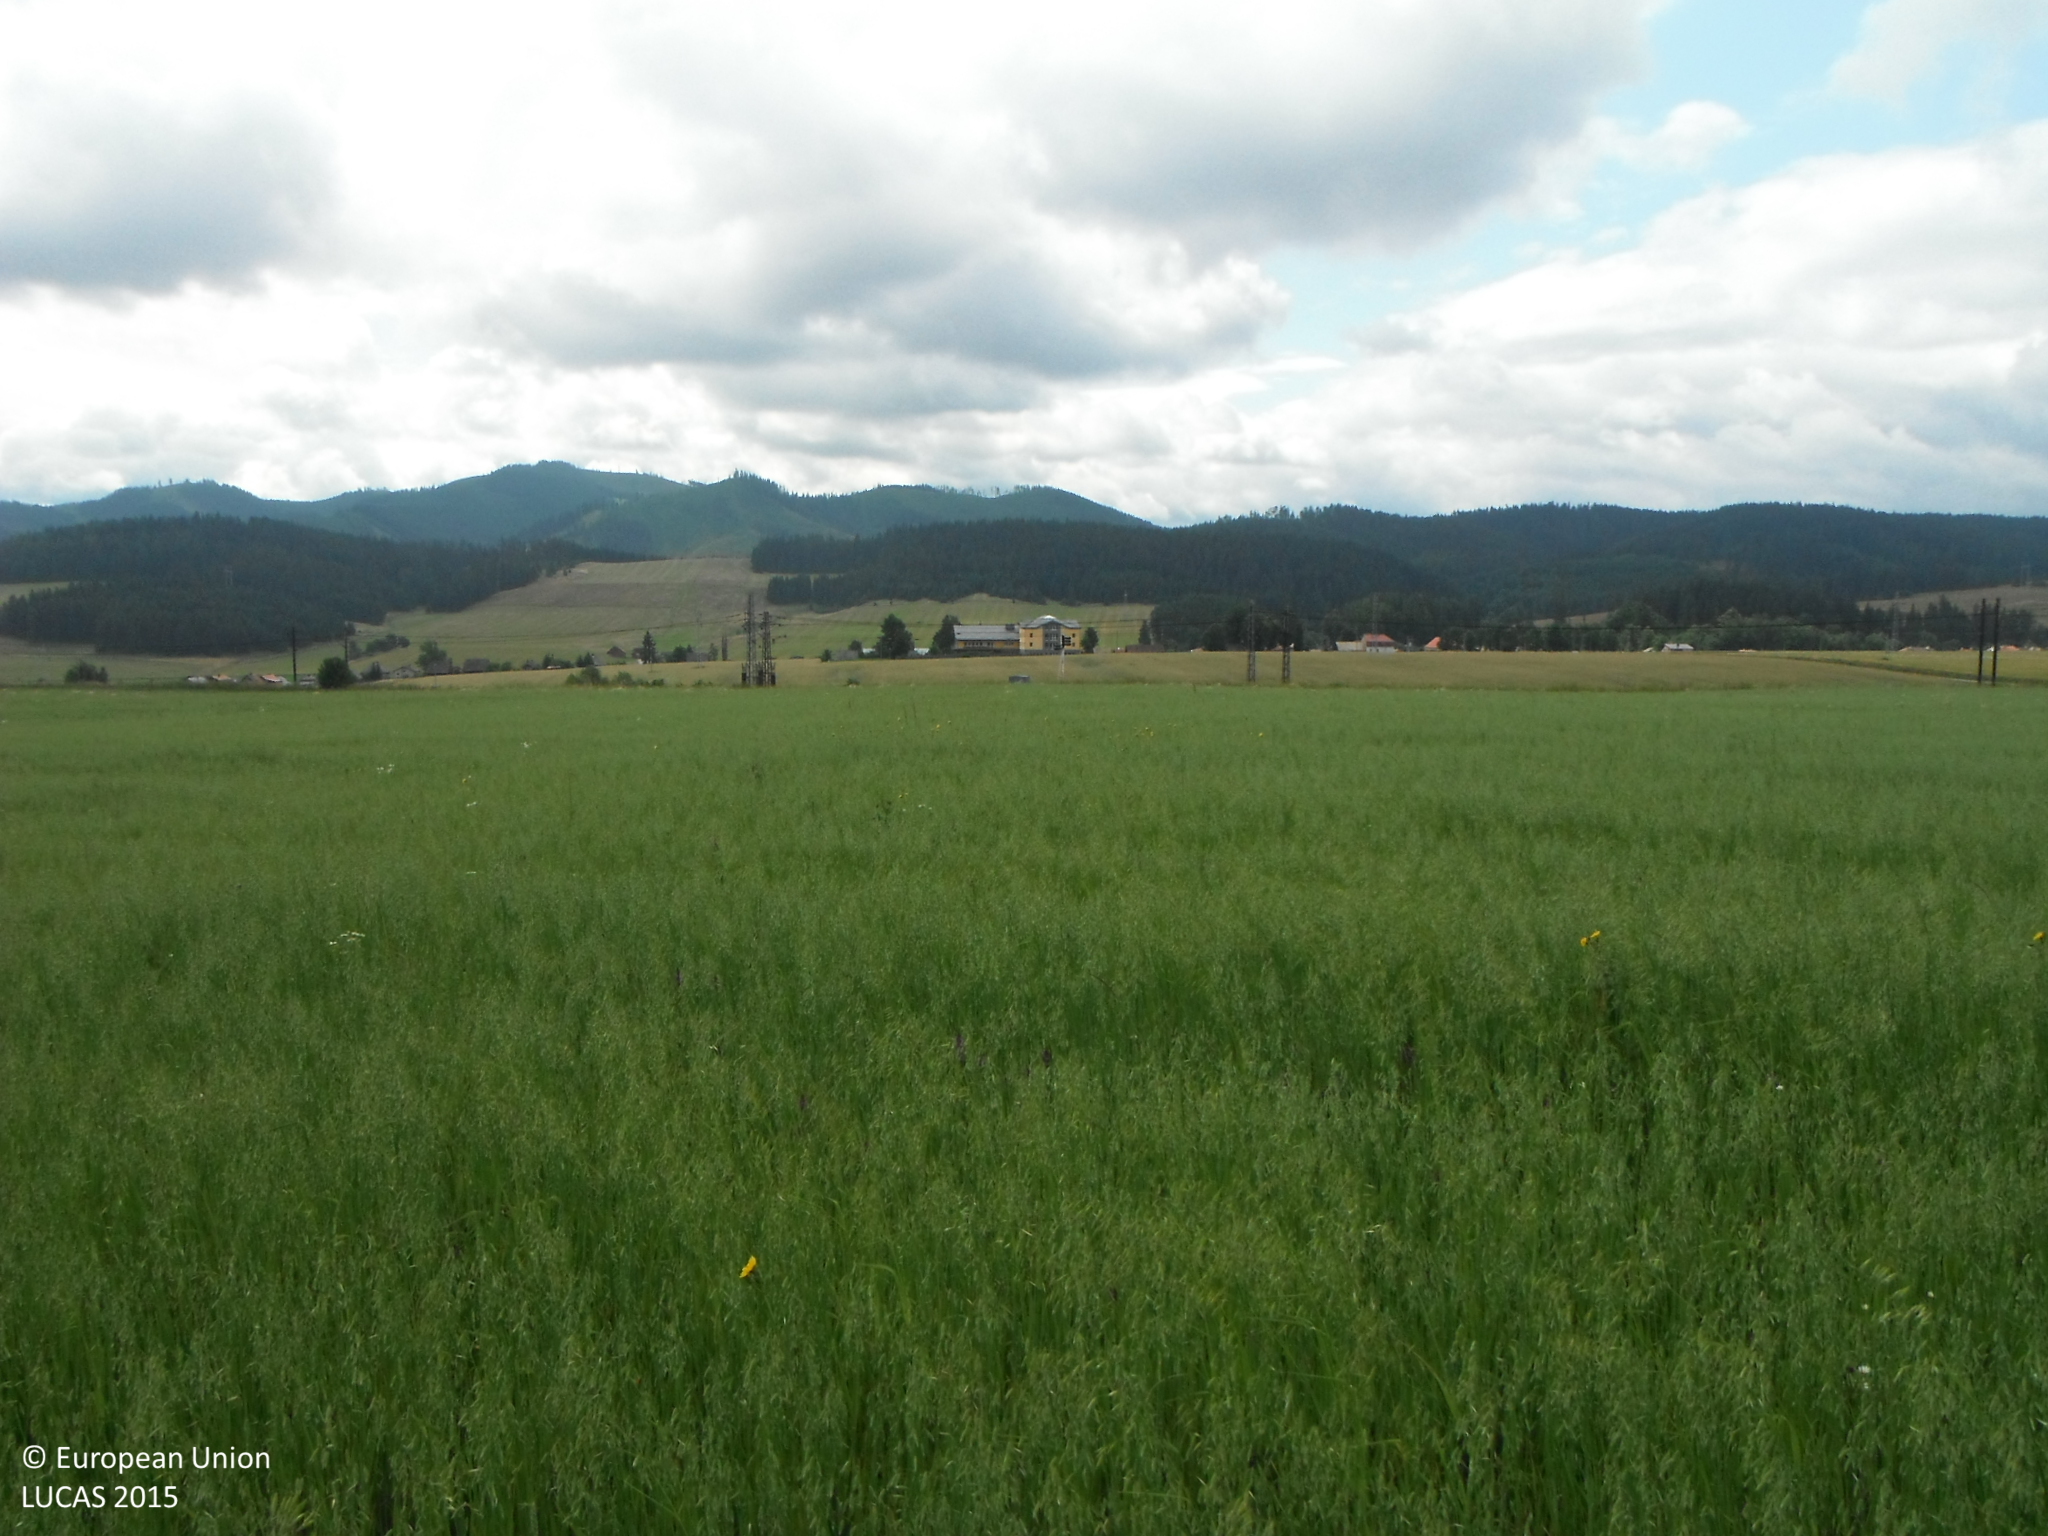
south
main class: Cropland
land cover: Oats
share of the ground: > 75 %
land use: Agriculture (excluding fallow land and kitchen gardens)
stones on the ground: > 50 %
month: July
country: SK
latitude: 49.0598
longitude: 20.1457
